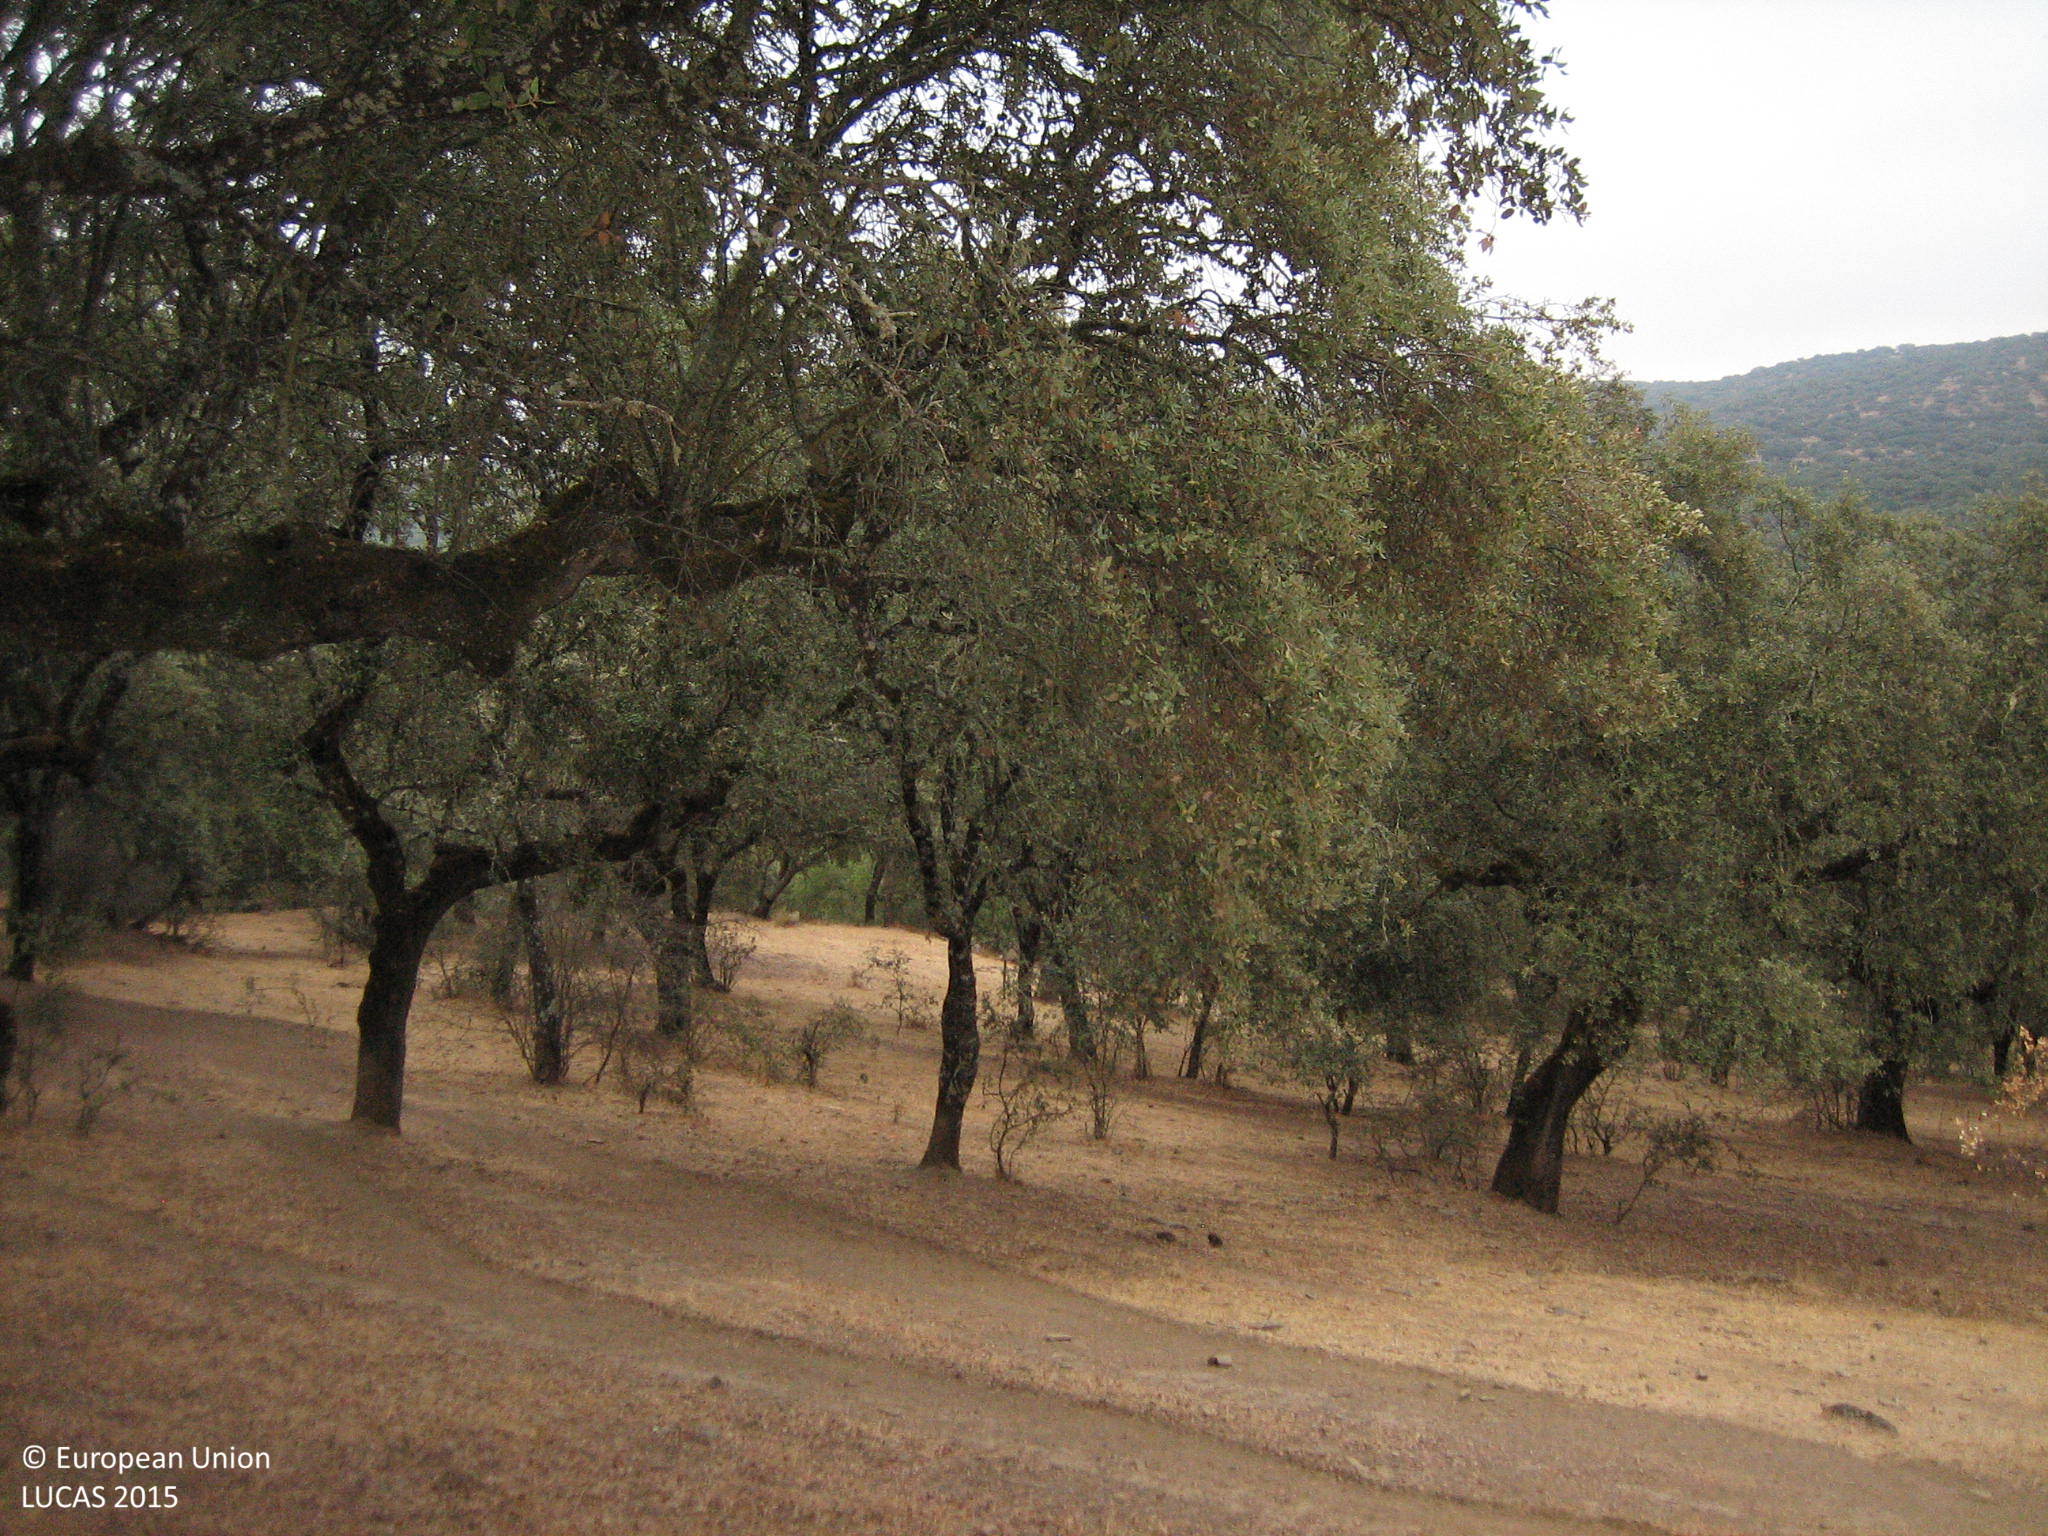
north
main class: Woodland
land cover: Broadleaved woodland
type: broadleaved evergreen forest
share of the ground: 25 - 50 %
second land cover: Grassland without tree/shrub cover
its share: > 75 %
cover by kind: herbaceous plants 55 %, broadleaved forest trees 40 %, shrubs 5 %
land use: Forestry
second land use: Agriculture (excluding fallow land and kitchen gardens)
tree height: > 5 m
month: September
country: ES
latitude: 38.3386
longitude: -6.8409
